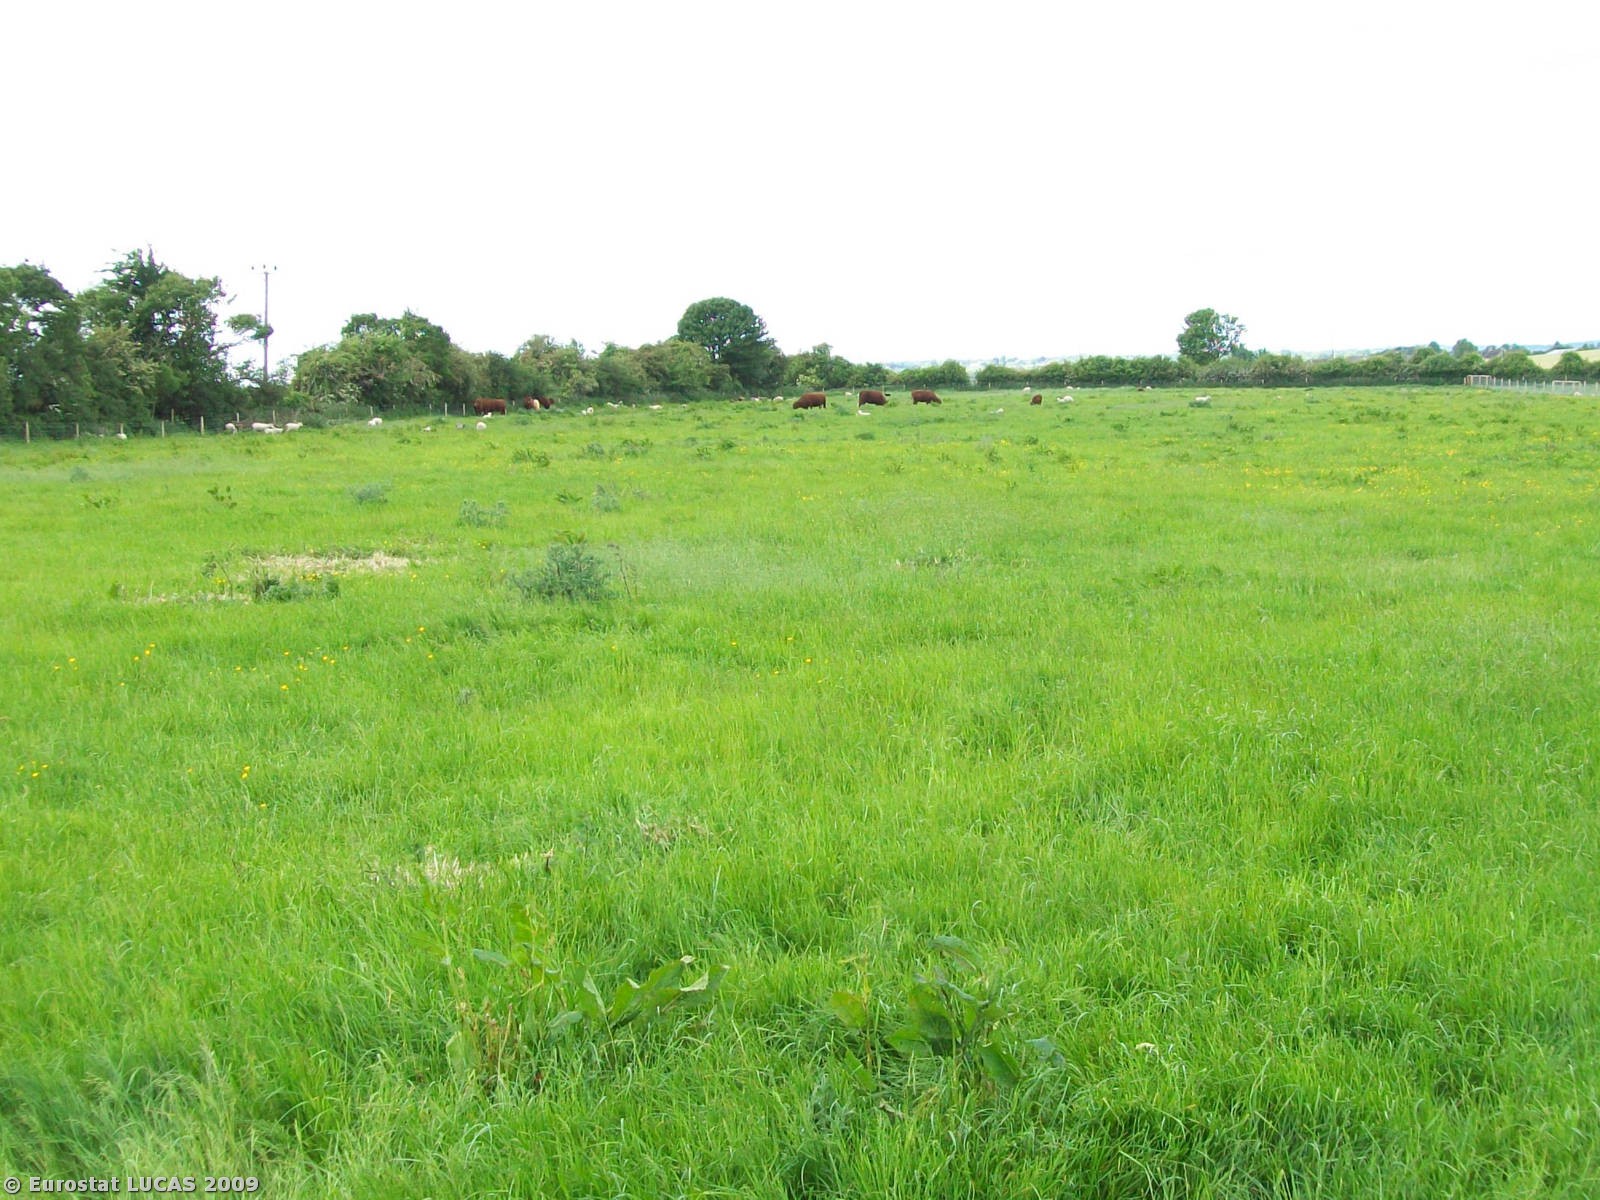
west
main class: Grassland
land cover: Grassland without tree/shrub cover
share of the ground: > 75 %
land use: Agriculture (excluding fallow land and kitchen gardens)
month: May
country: GB
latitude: 51.3488
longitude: -2.1648
